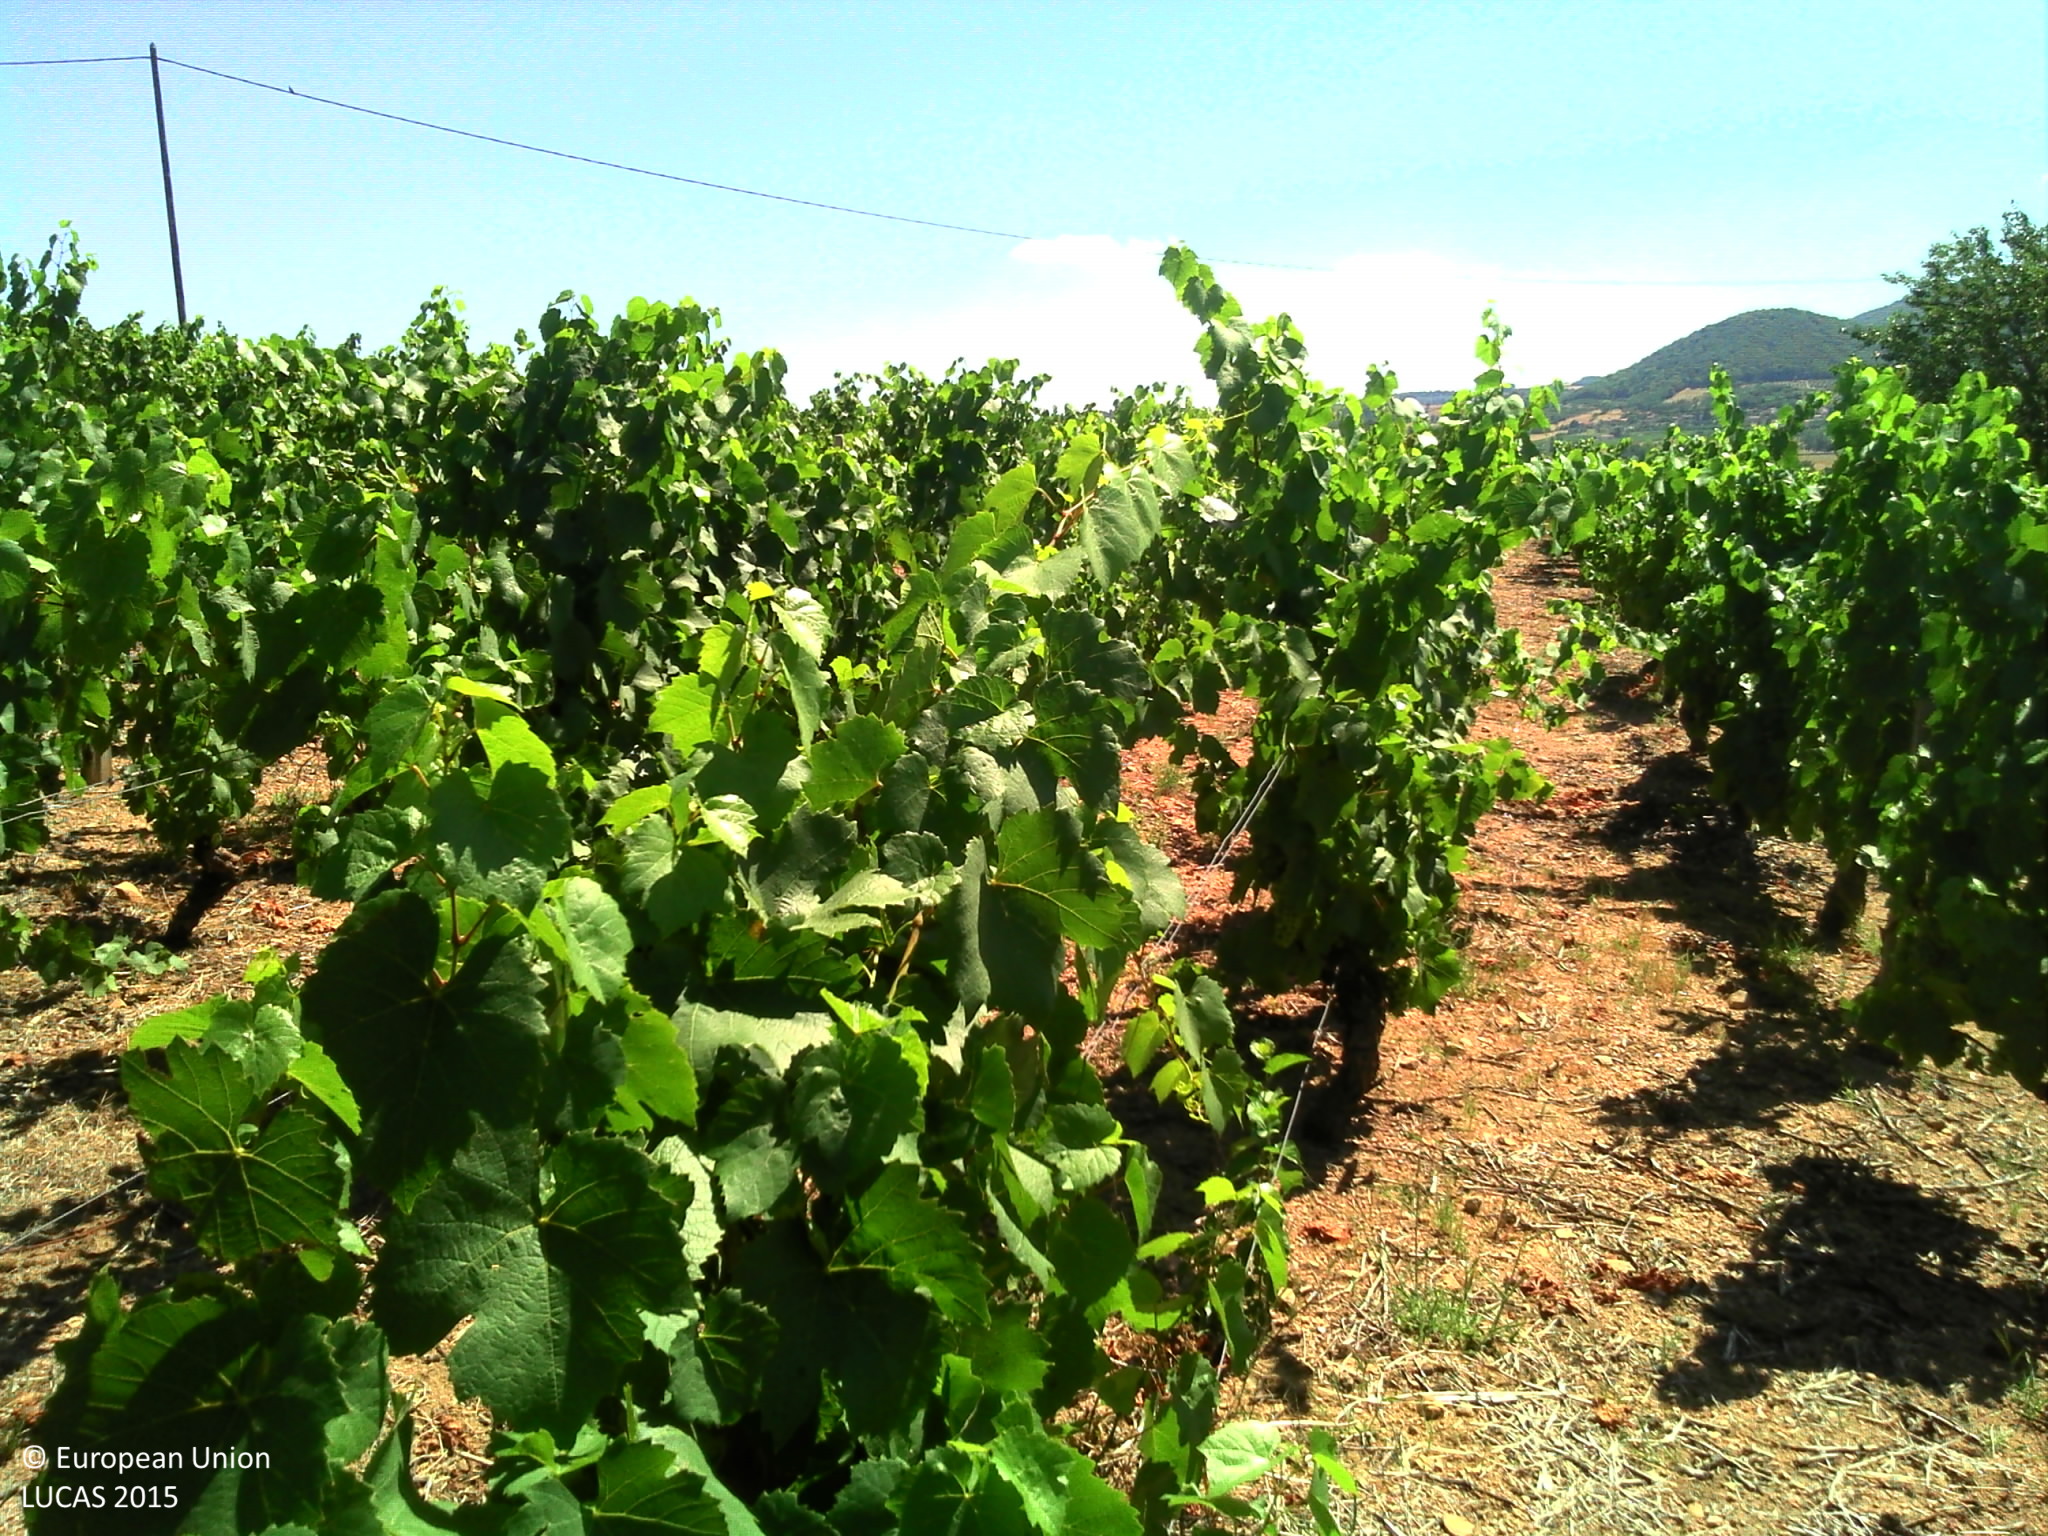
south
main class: Cropland
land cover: Vineyards
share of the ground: 50 - 75 %
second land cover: Other bare soil
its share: > 75 %
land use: Agriculture (excluding fallow land and kitchen gardens)
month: July
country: FR
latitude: 45.8695
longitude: 4.5538
